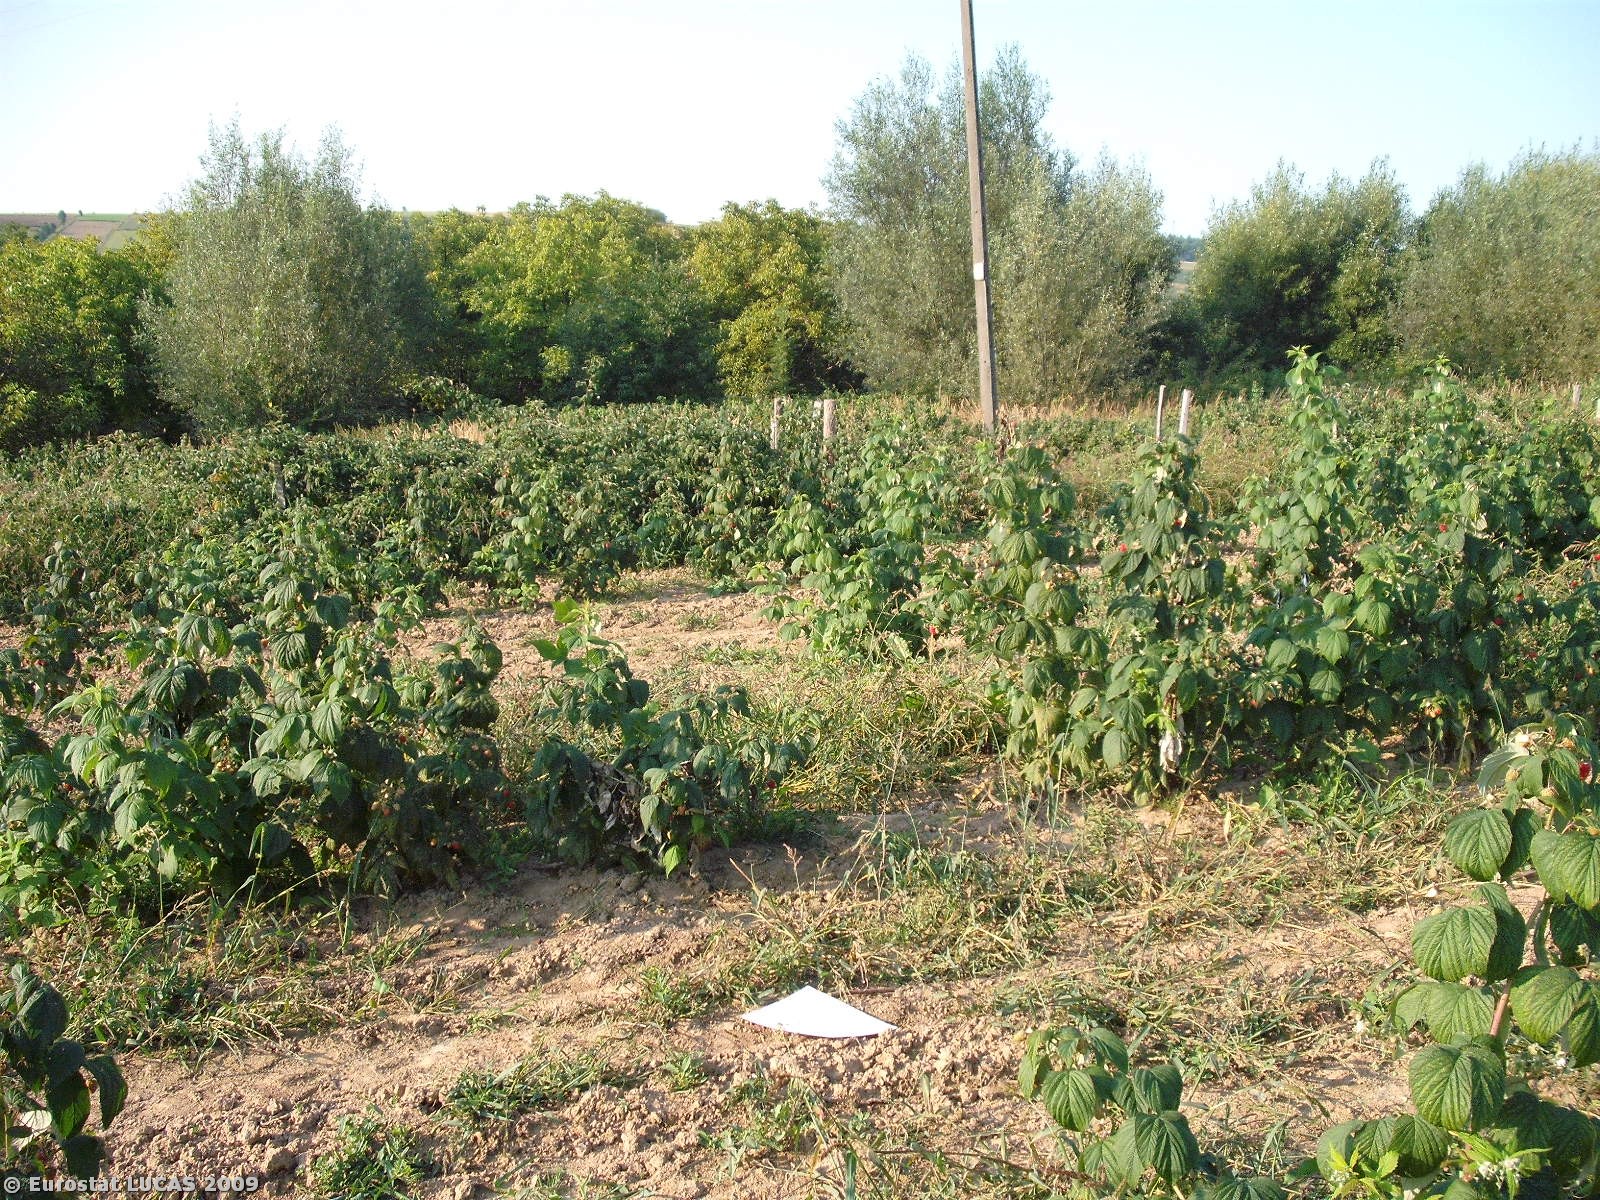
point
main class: Cropland
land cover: Other fruit trees and berries
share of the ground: 50 - 75 %
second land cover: Grassland with sparse tree/shrub cover
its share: > 75 %
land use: Agriculture (excluding fallow land and kitchen gardens)
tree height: < 5 m
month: August
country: PL
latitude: 49.9207
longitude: 22.4180
